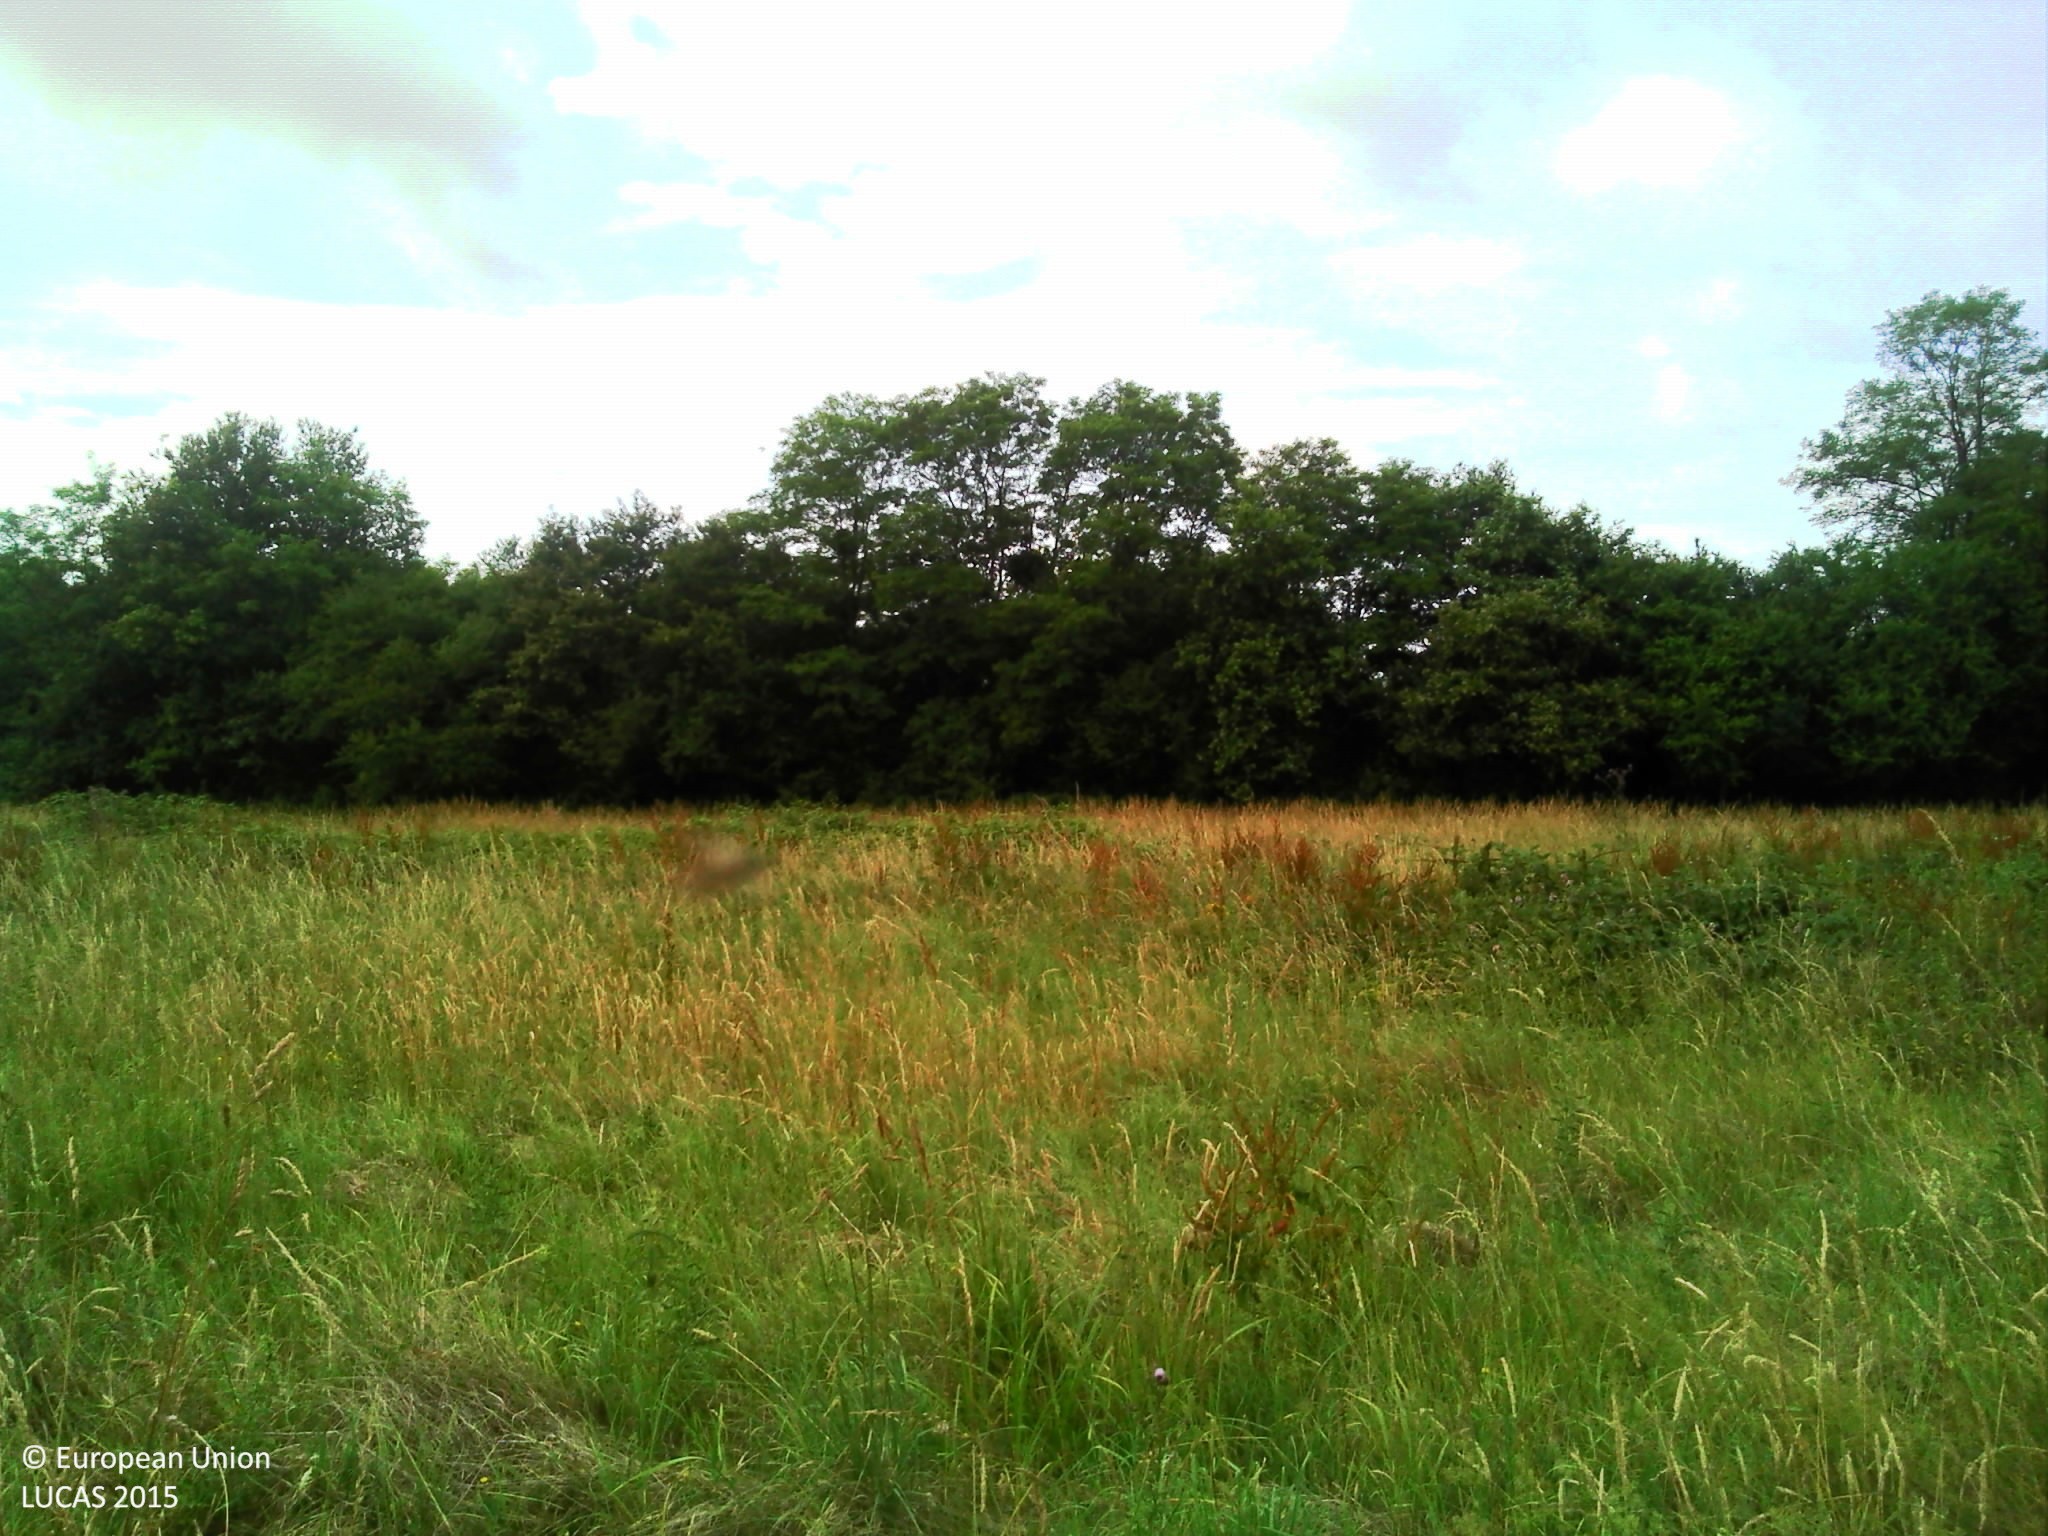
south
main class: Grassland
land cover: Grassland without tree/shrub cover
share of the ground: > 75 %
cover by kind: herbaceous plants 100 %
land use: Agriculture (excluding fallow land and kitchen gardens)
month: June
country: FR
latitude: 47.6442
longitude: 2.5238
